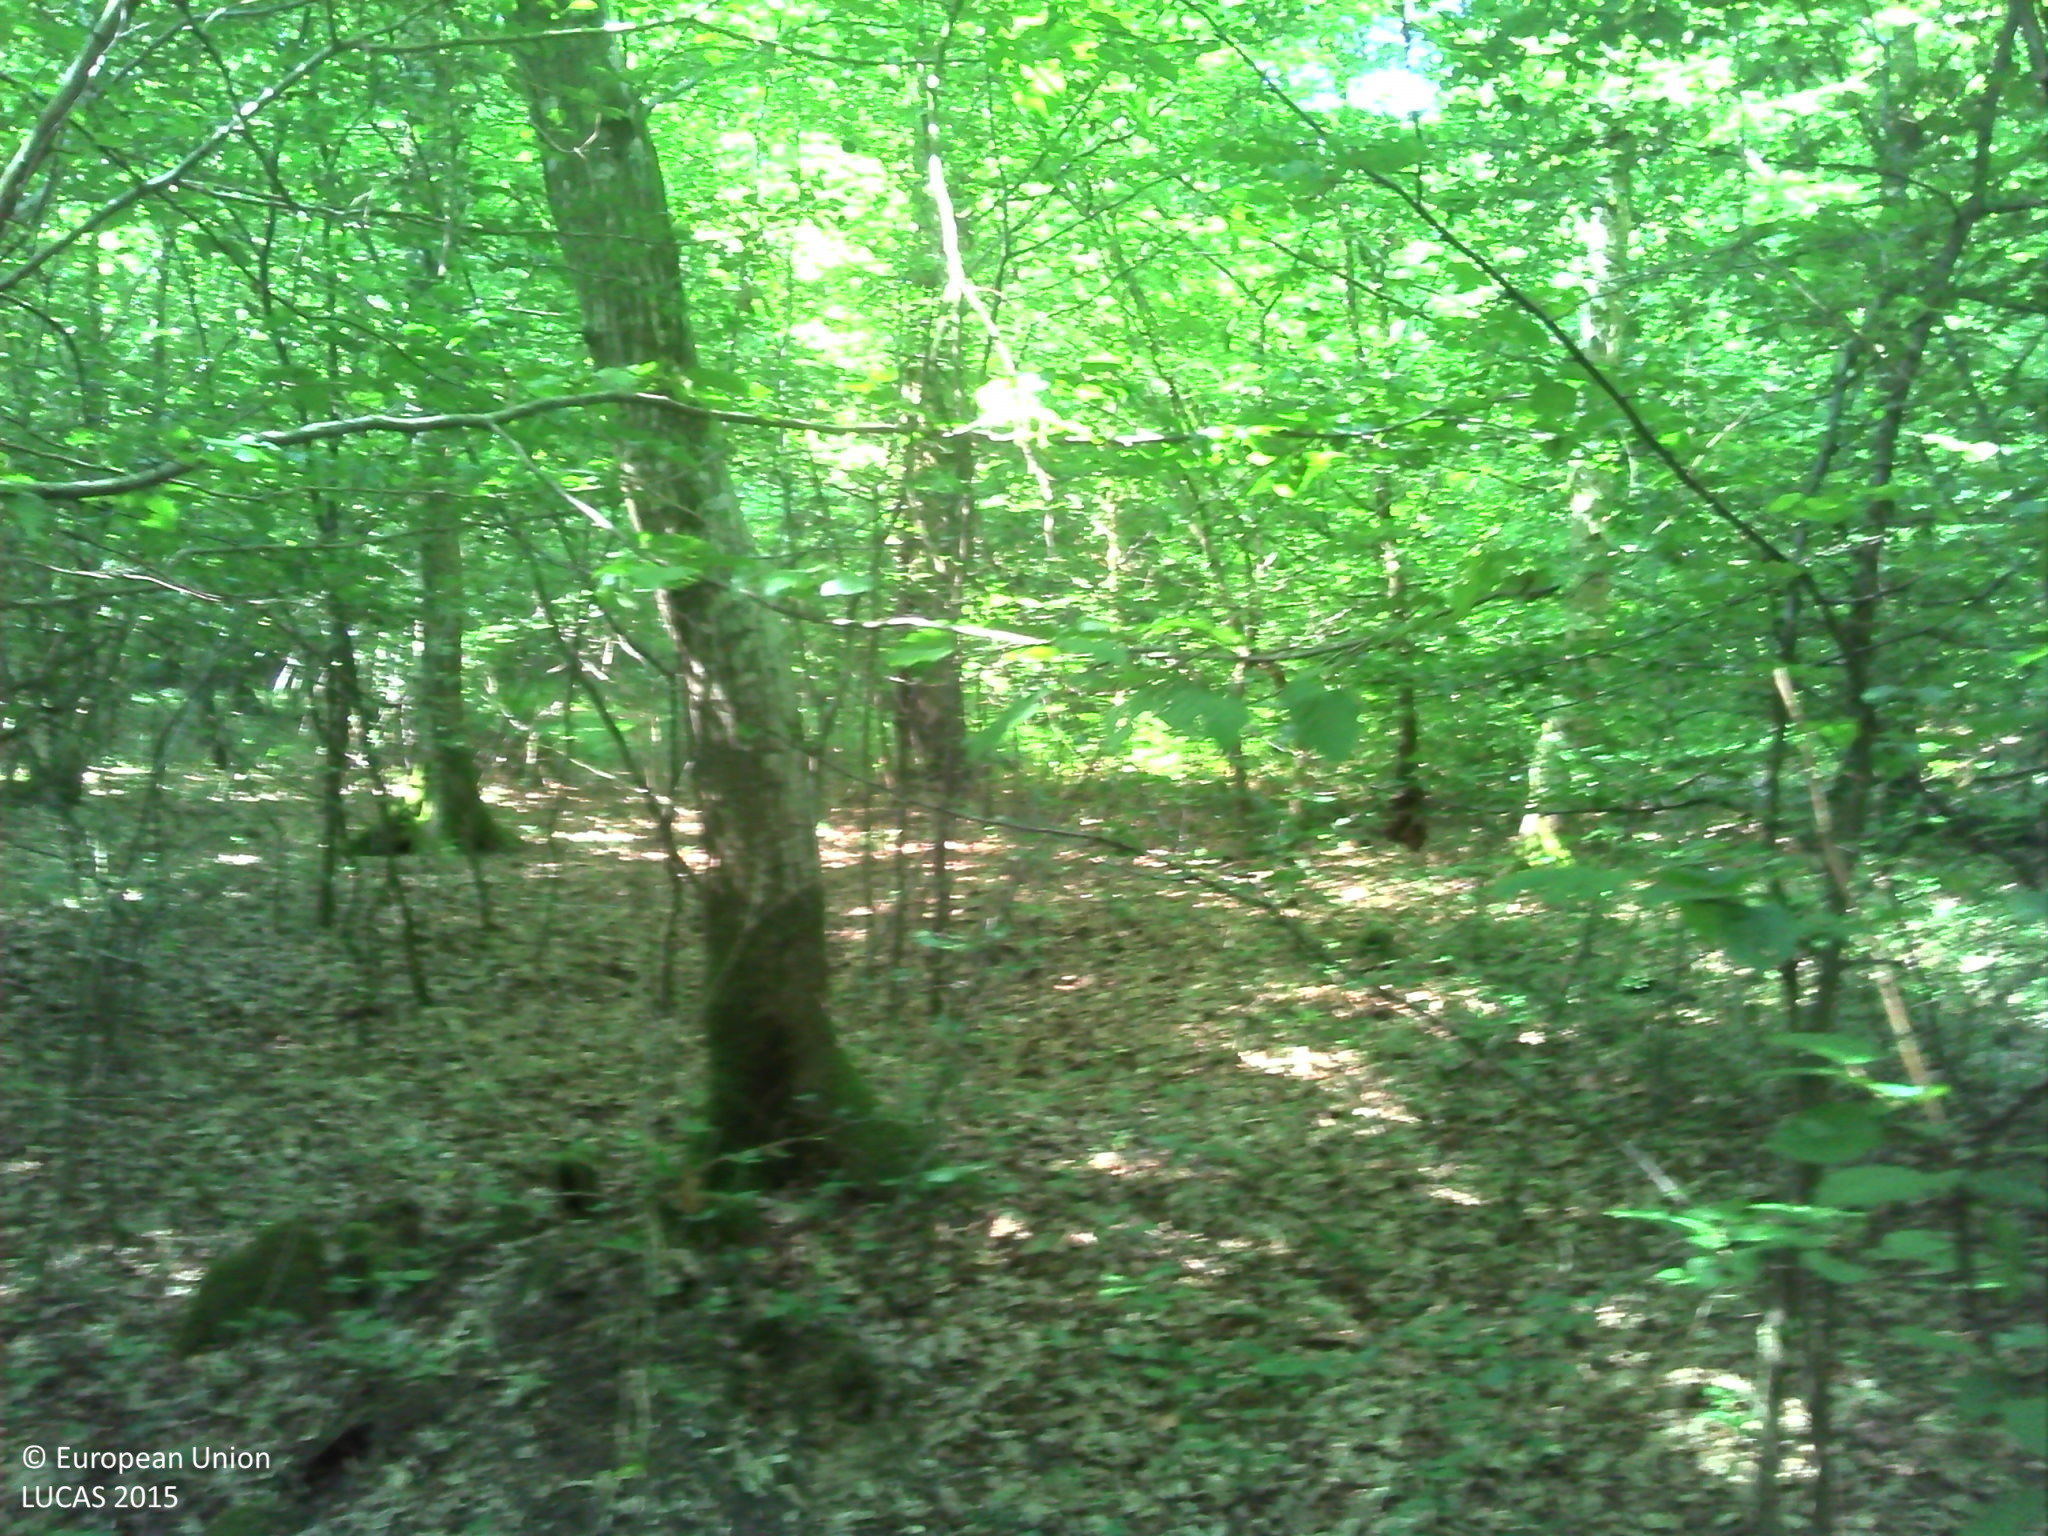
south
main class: Woodland
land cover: Broadleaved woodland
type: mesophytic deciduous forest
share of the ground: > 75 %
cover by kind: broadleaved forest trees 80 %, herbaceous plants 10 %, consolidated bare surface 10 %
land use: Forestry
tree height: > 5 m
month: July
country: FR
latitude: 48.9682
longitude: 1.1139
